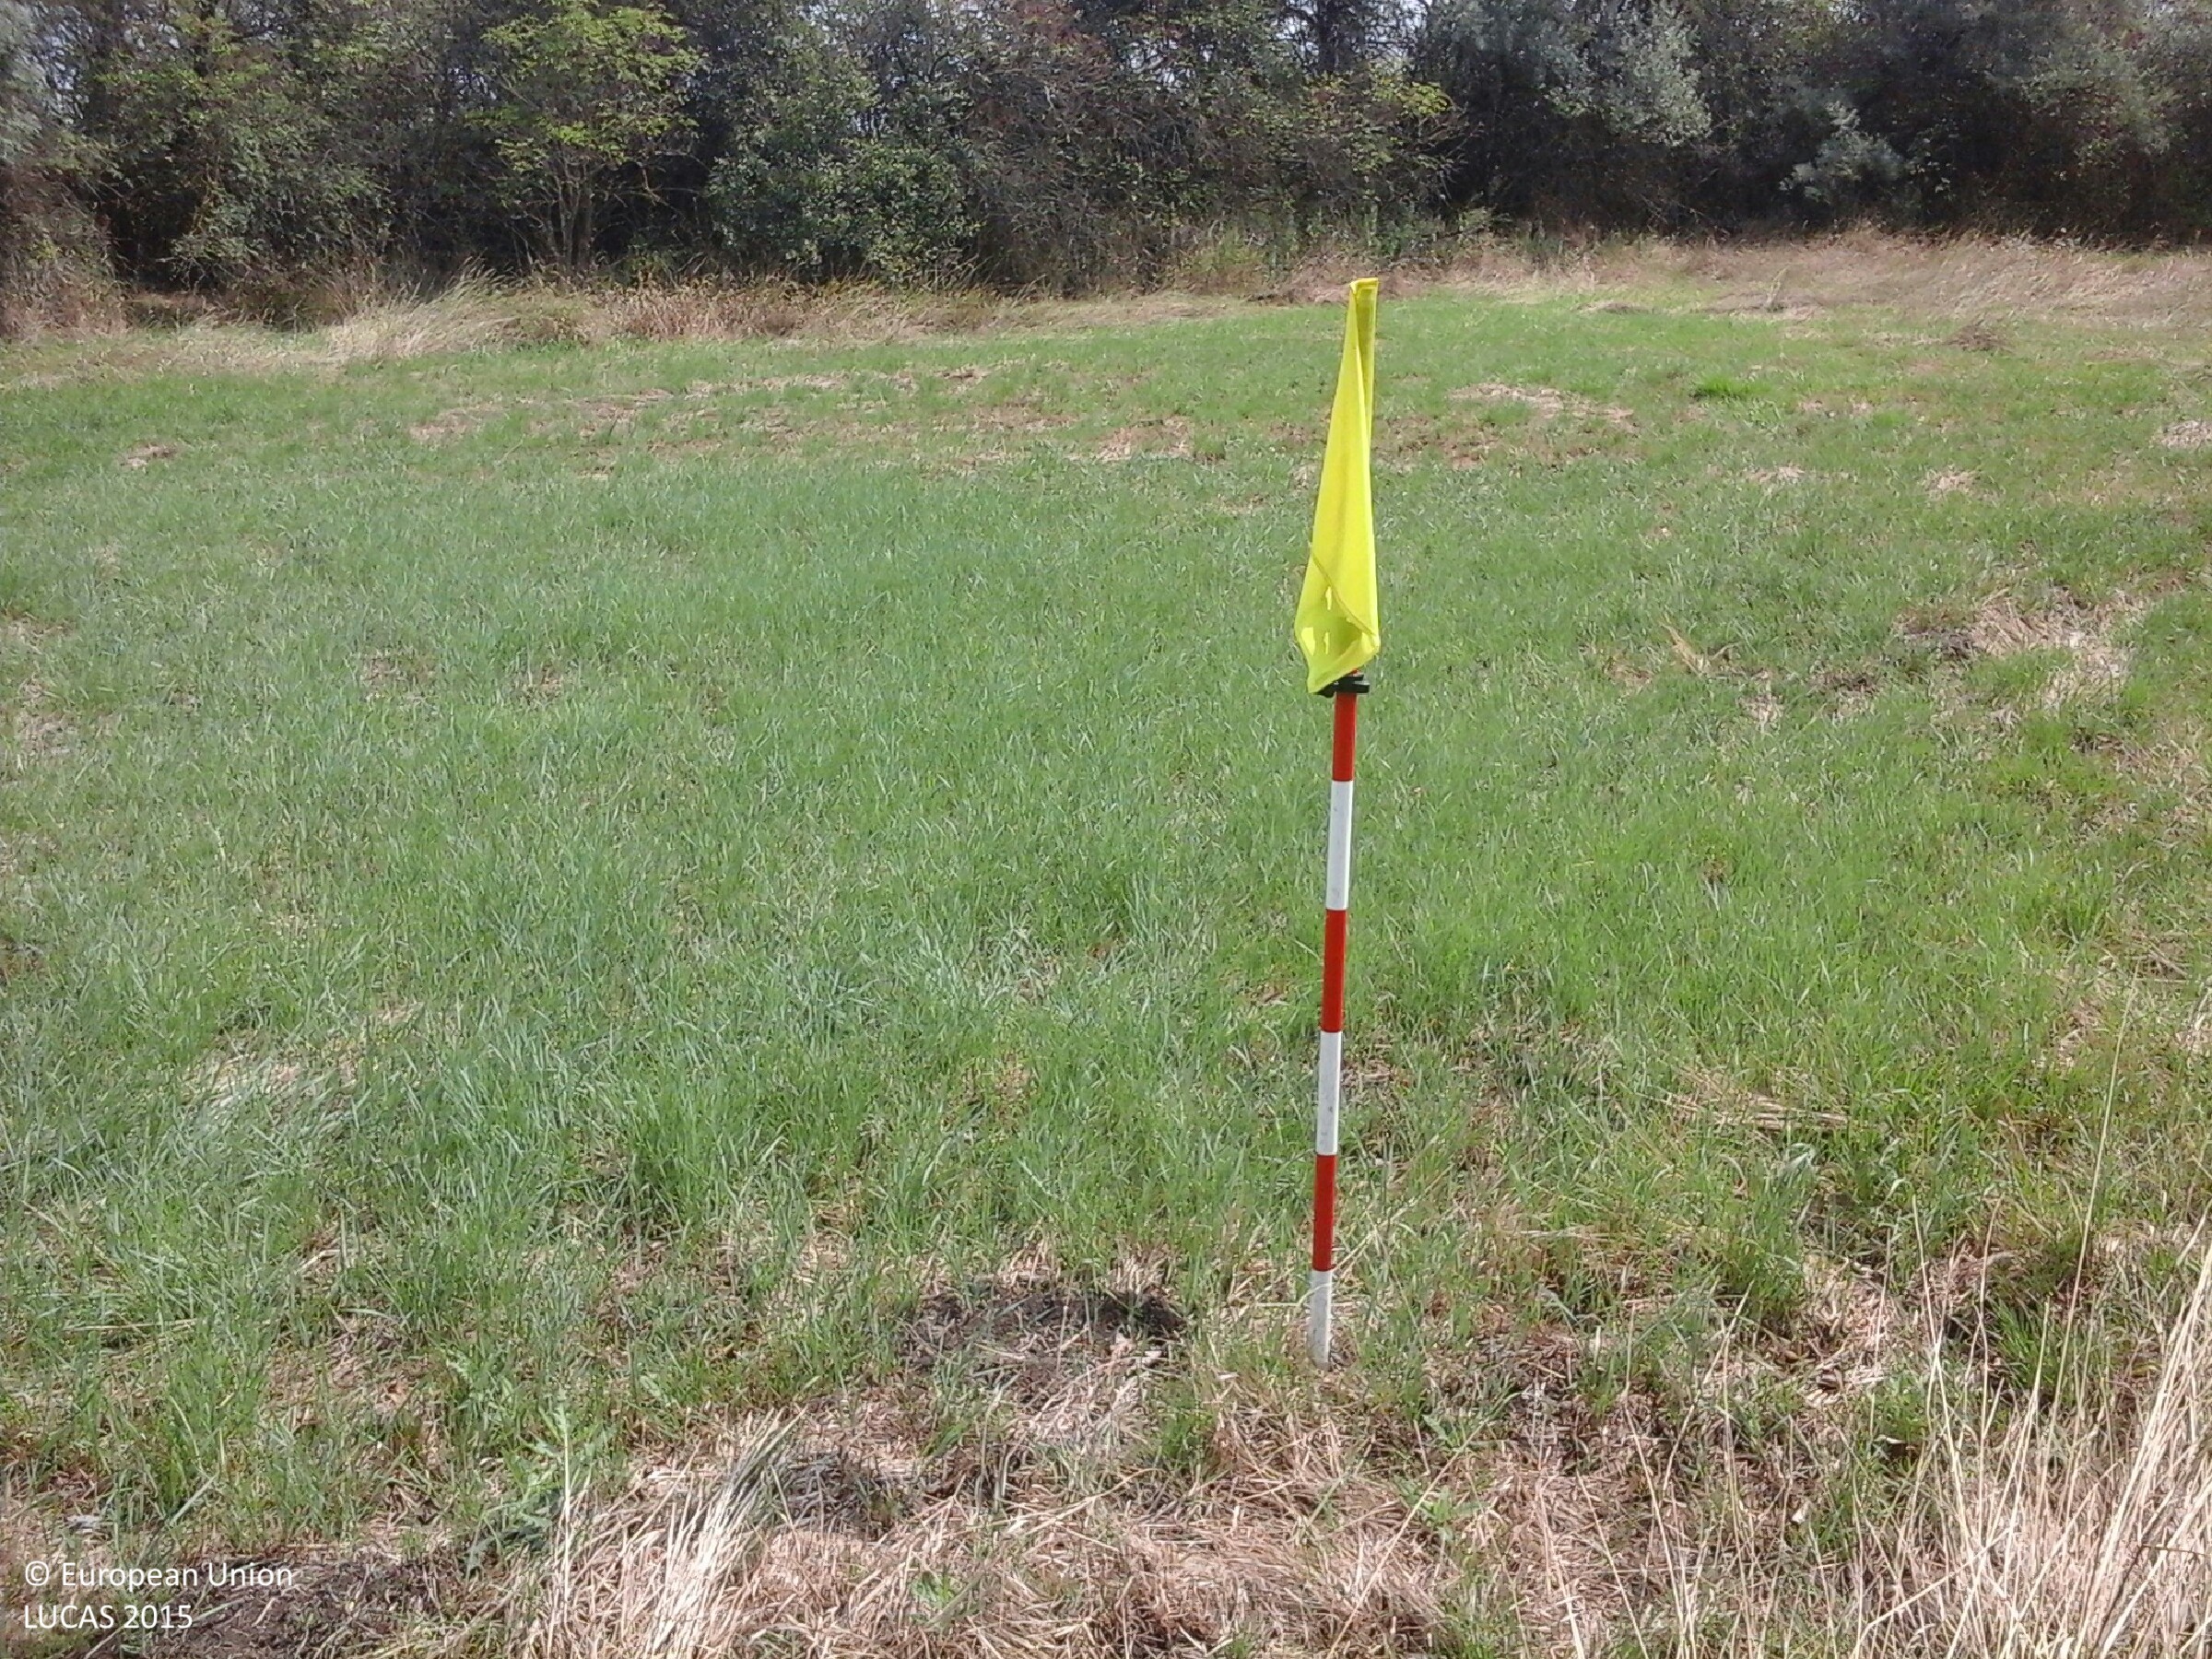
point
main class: Grassland
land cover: Grassland without tree/shrub cover
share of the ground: > 75 %
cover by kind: herbaceous plants 100 %
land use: Forestry
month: August
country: HU
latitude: 47.5603
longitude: 20.8401
